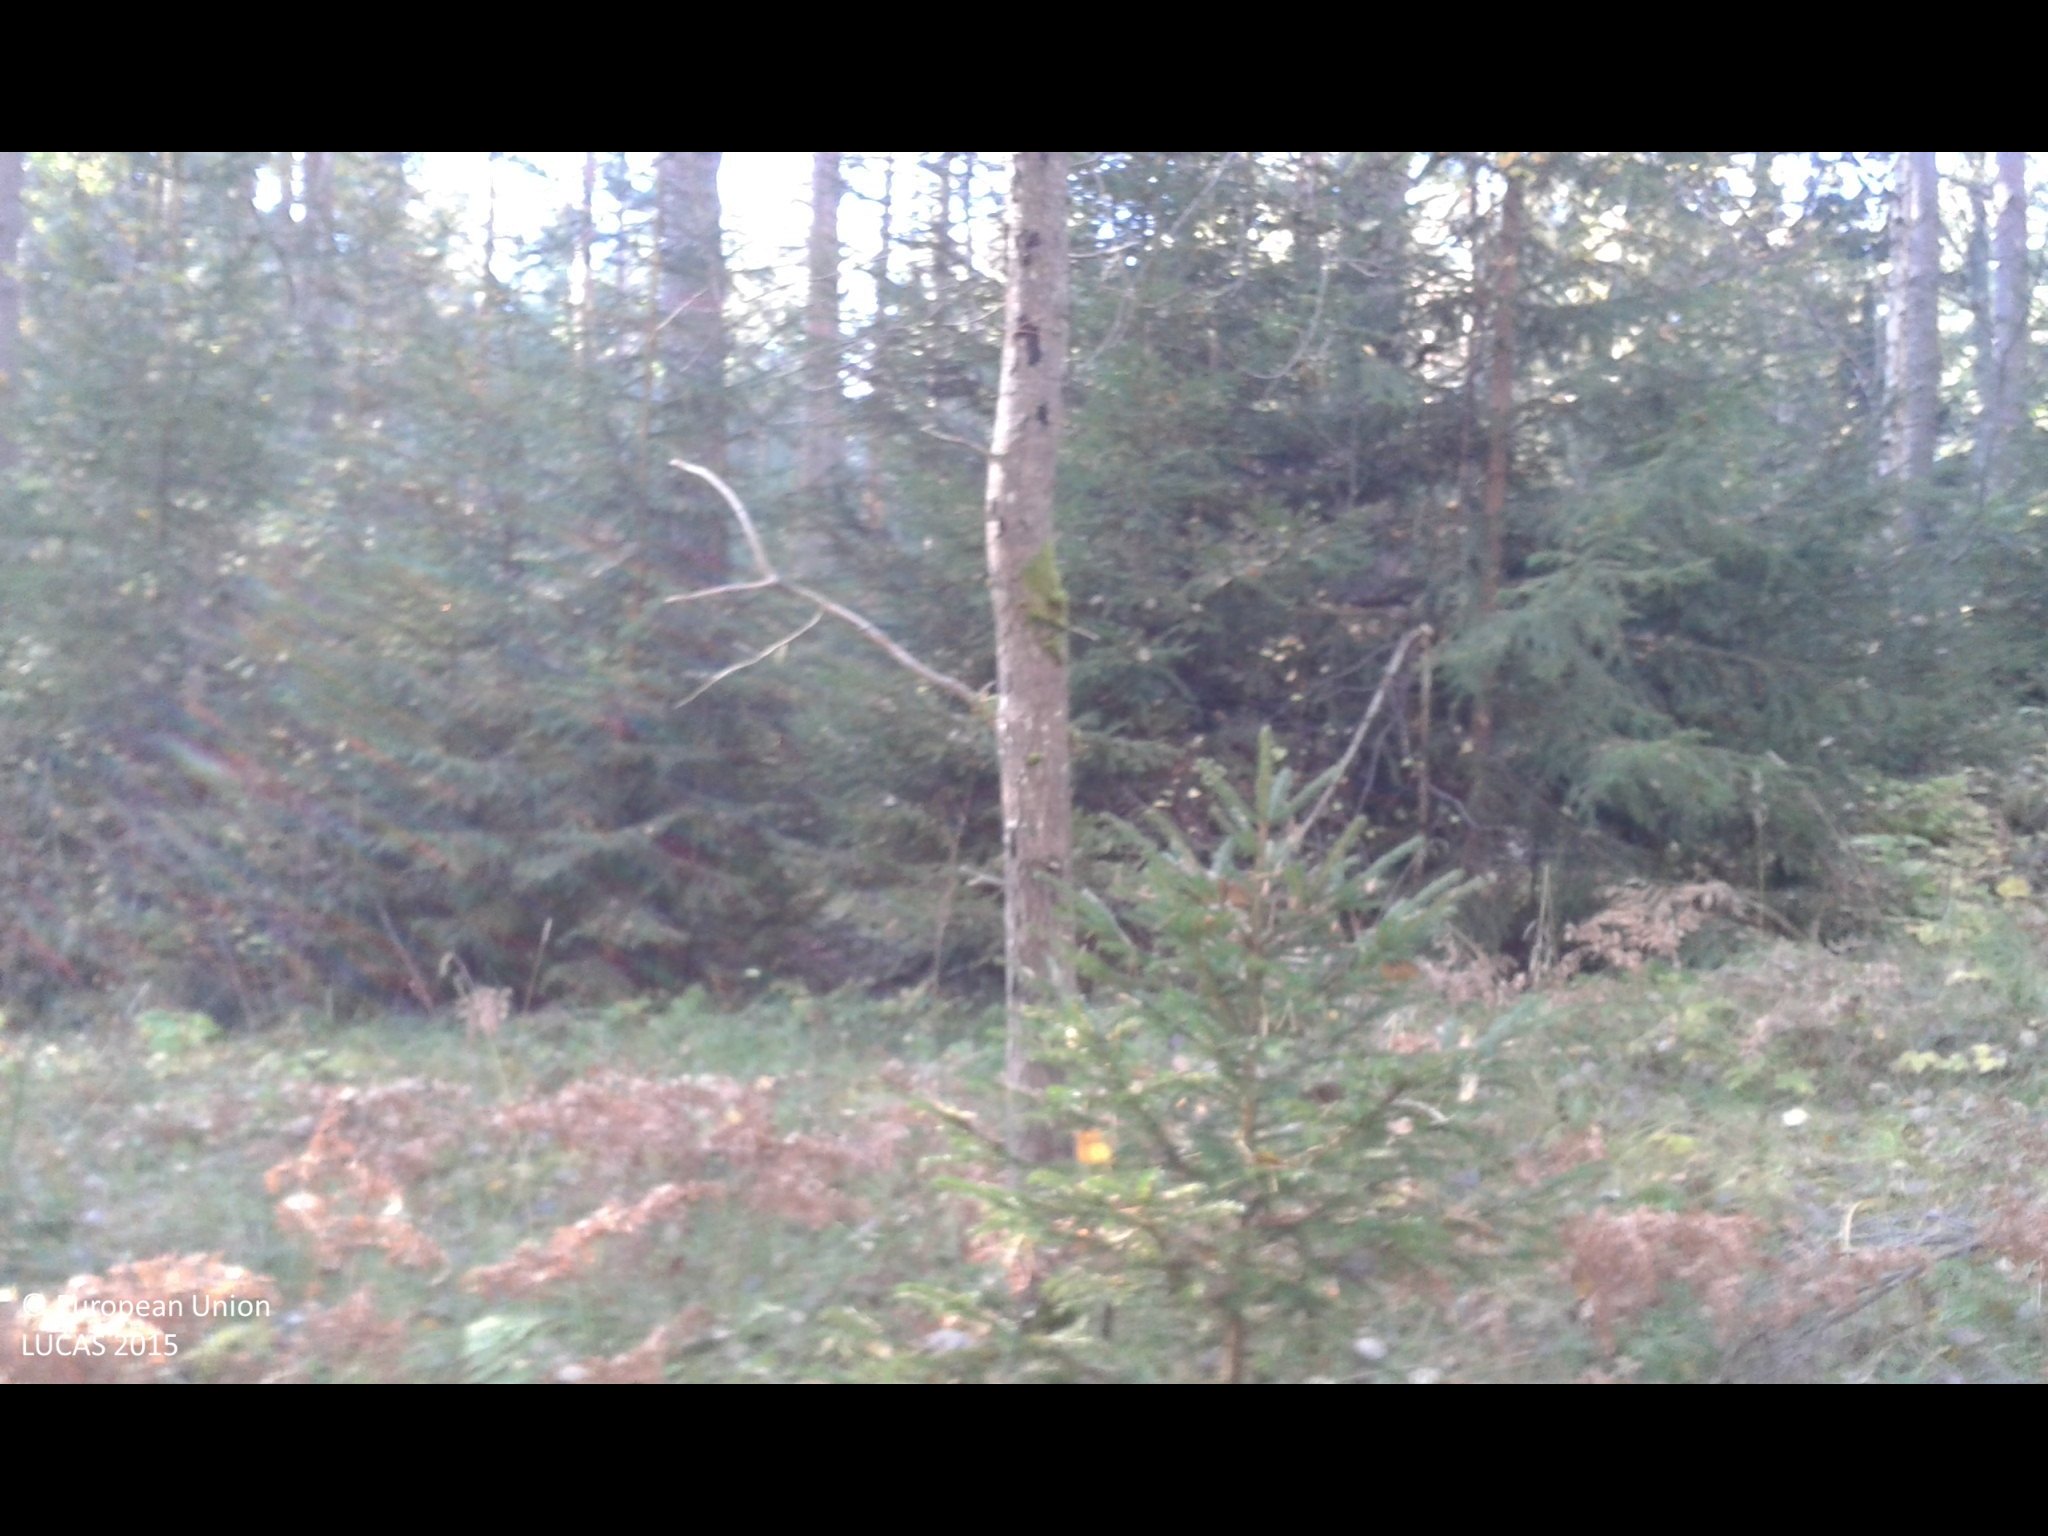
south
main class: Woodland
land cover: Pine dominated coniferous woodland
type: boreal forest
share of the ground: 50 - 75 %
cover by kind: coniferous forest trees 55 %, herbaceous plants 30 %, broadleaved forest trees 15 %
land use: Forestry
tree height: > 5 m
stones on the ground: < 10 %
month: October
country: SE
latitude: 58.8866
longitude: 17.3366
